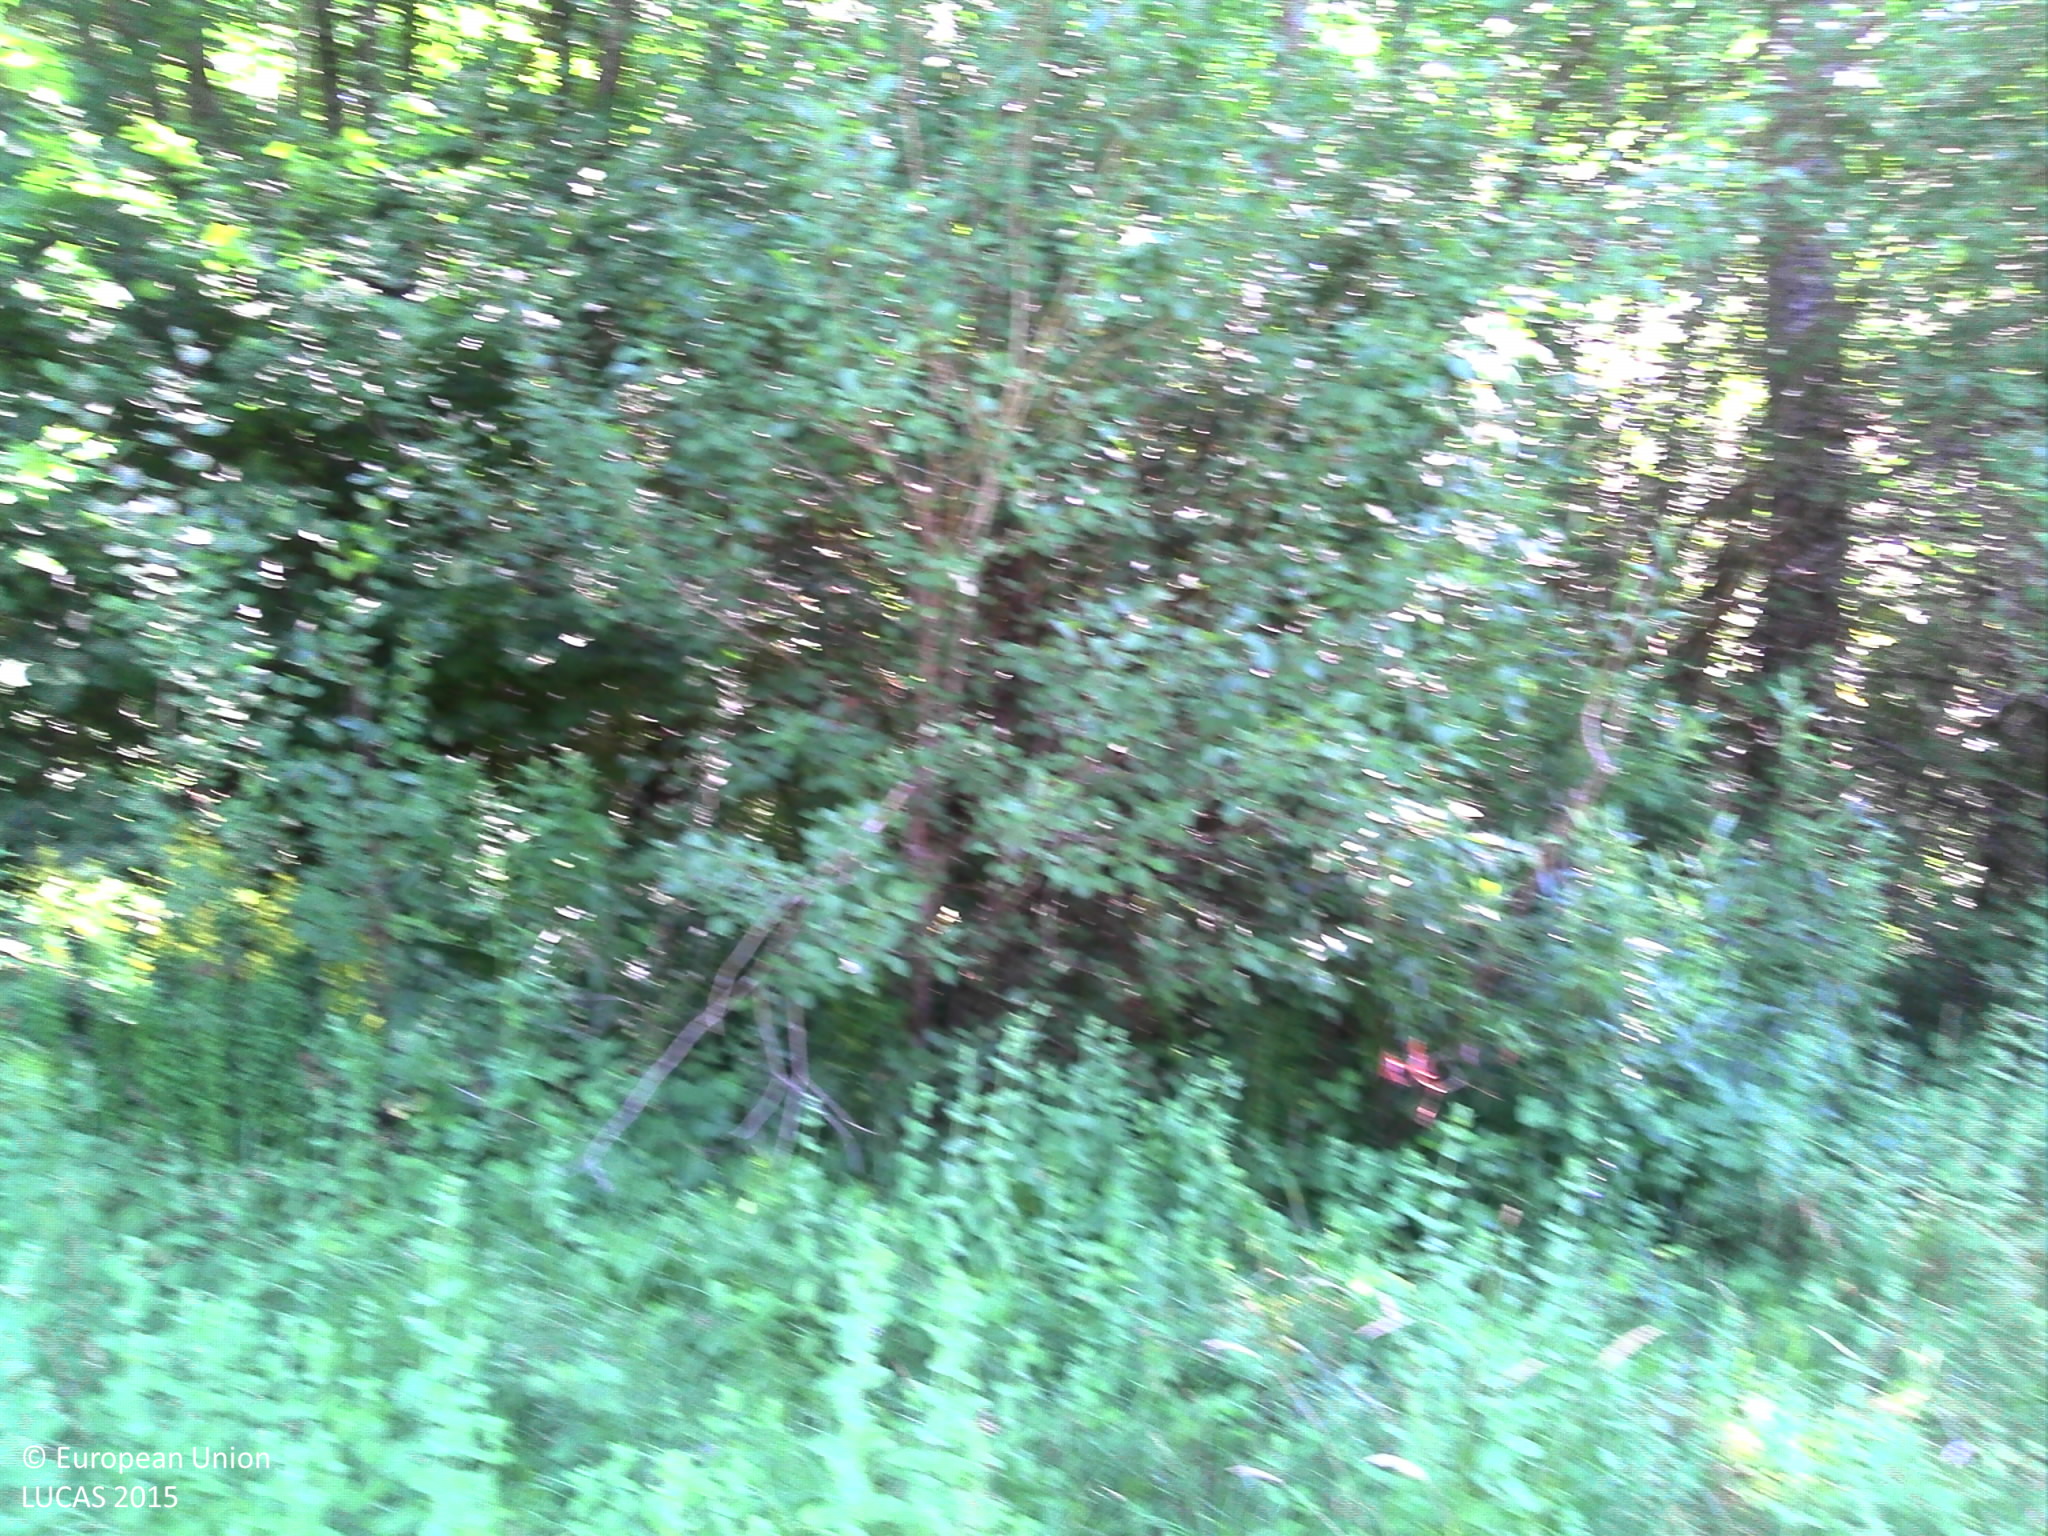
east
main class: Grassland
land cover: Grassland without tree/shrub cover
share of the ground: > 75 %
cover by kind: herbaceous plants 100 %
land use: Agriculture (excluding fallow land and kitchen gardens)
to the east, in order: Grassland without tree/shrub cover; Broadleaved woodland; Ditches and canals; Rivers and streams; Broadleaved woodland; Tracks; Broadleaved woodland; Fences; Grassland without tree/shrub cover; Fences; Grassland without tree/shrub cover; Tracks; Broadleaved woodland; Fences; Tracks
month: June
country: FR
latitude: 43.8965
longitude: 1.5485
